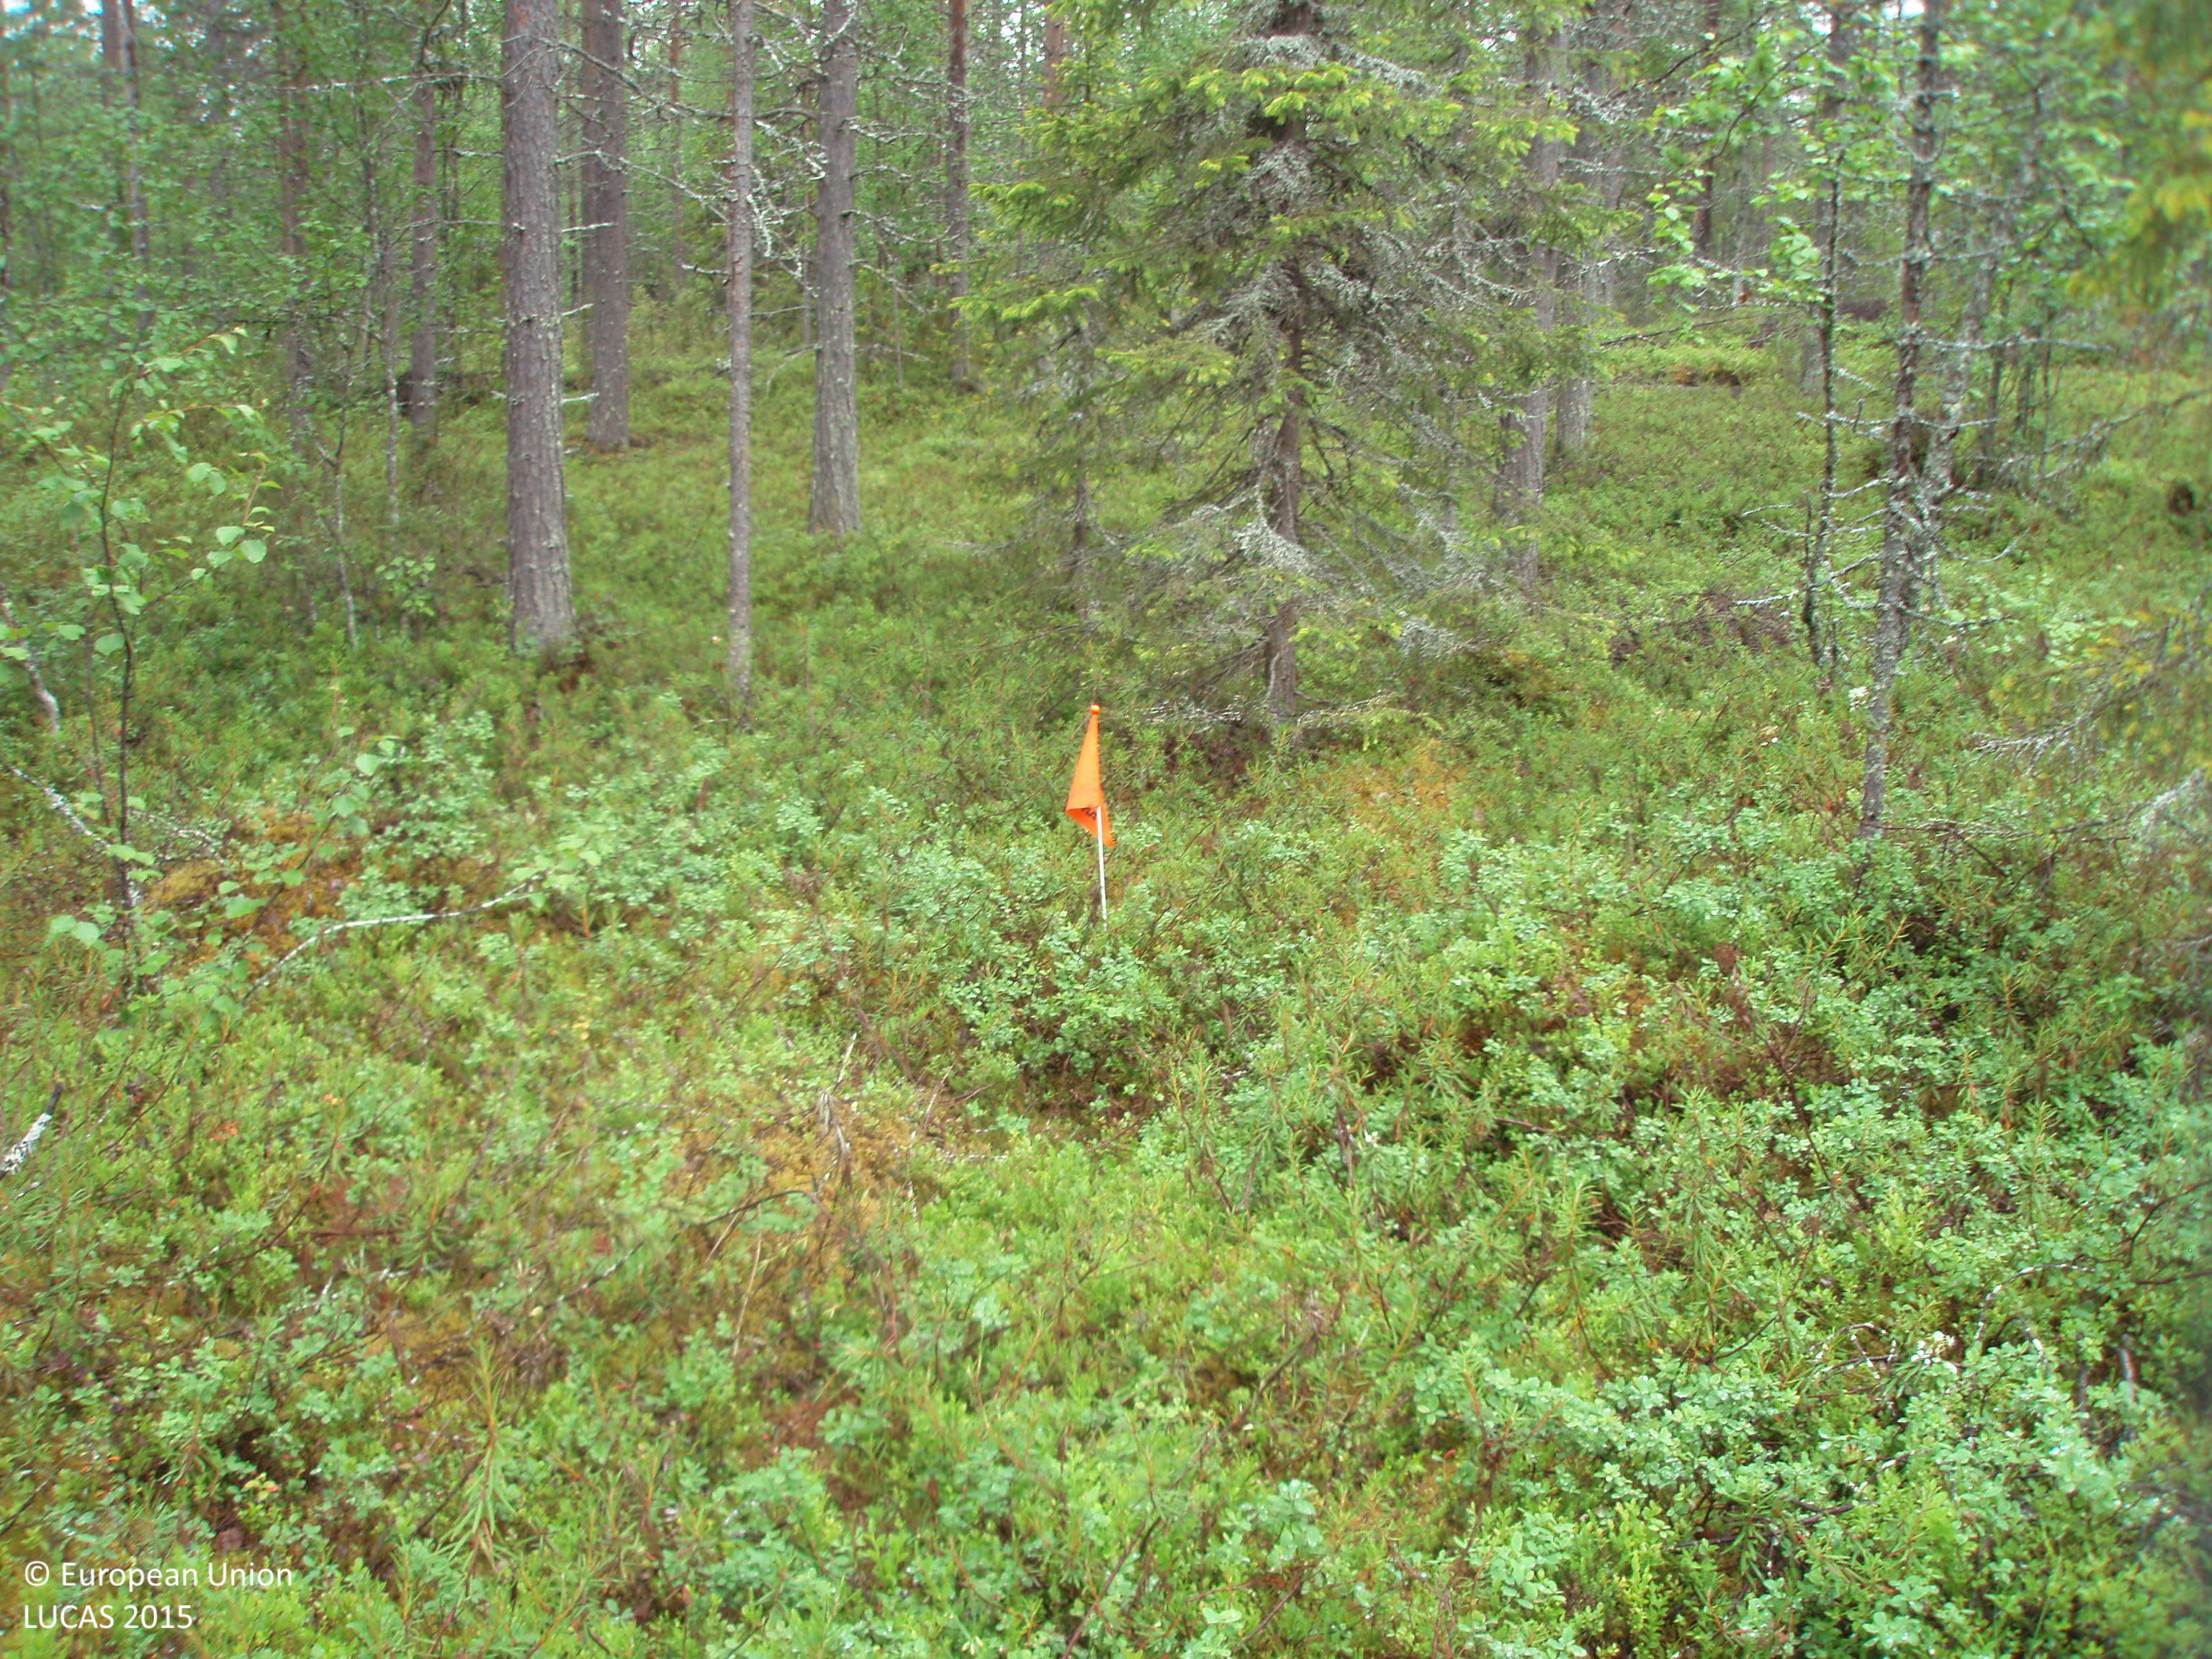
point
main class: Woodland
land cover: Pine dominated mixed woodland
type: boreal forest
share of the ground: > 75 %
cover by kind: coniferous forest trees 50 %, broadleaved forest trees 30 %, shrubs 20 %
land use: Forestry
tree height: > 5 m
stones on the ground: 10 - 25 %
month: July
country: FI
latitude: 66.8139
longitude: 28.6501
